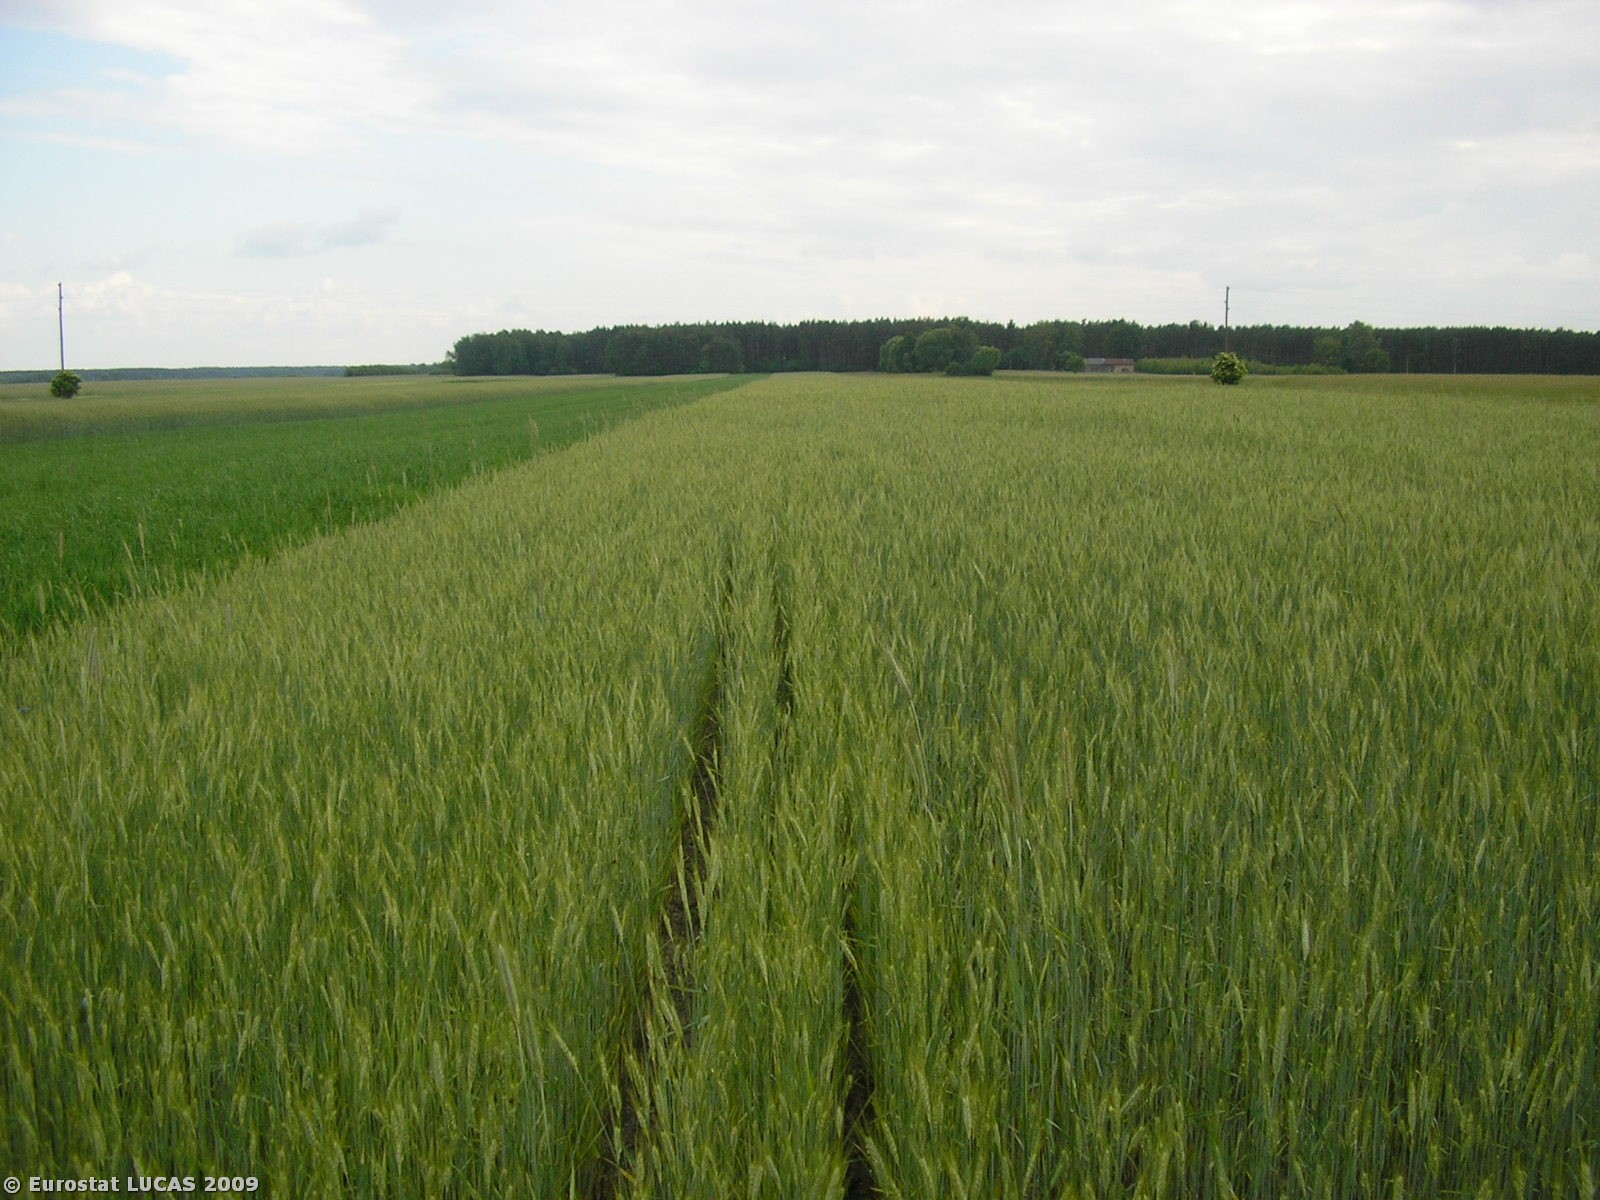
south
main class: Cropland
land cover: Triticale
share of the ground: 50 - 75 %
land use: Agriculture (excluding fallow land and kitchen gardens)
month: June
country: PL
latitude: 51.2342
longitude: 18.3394
